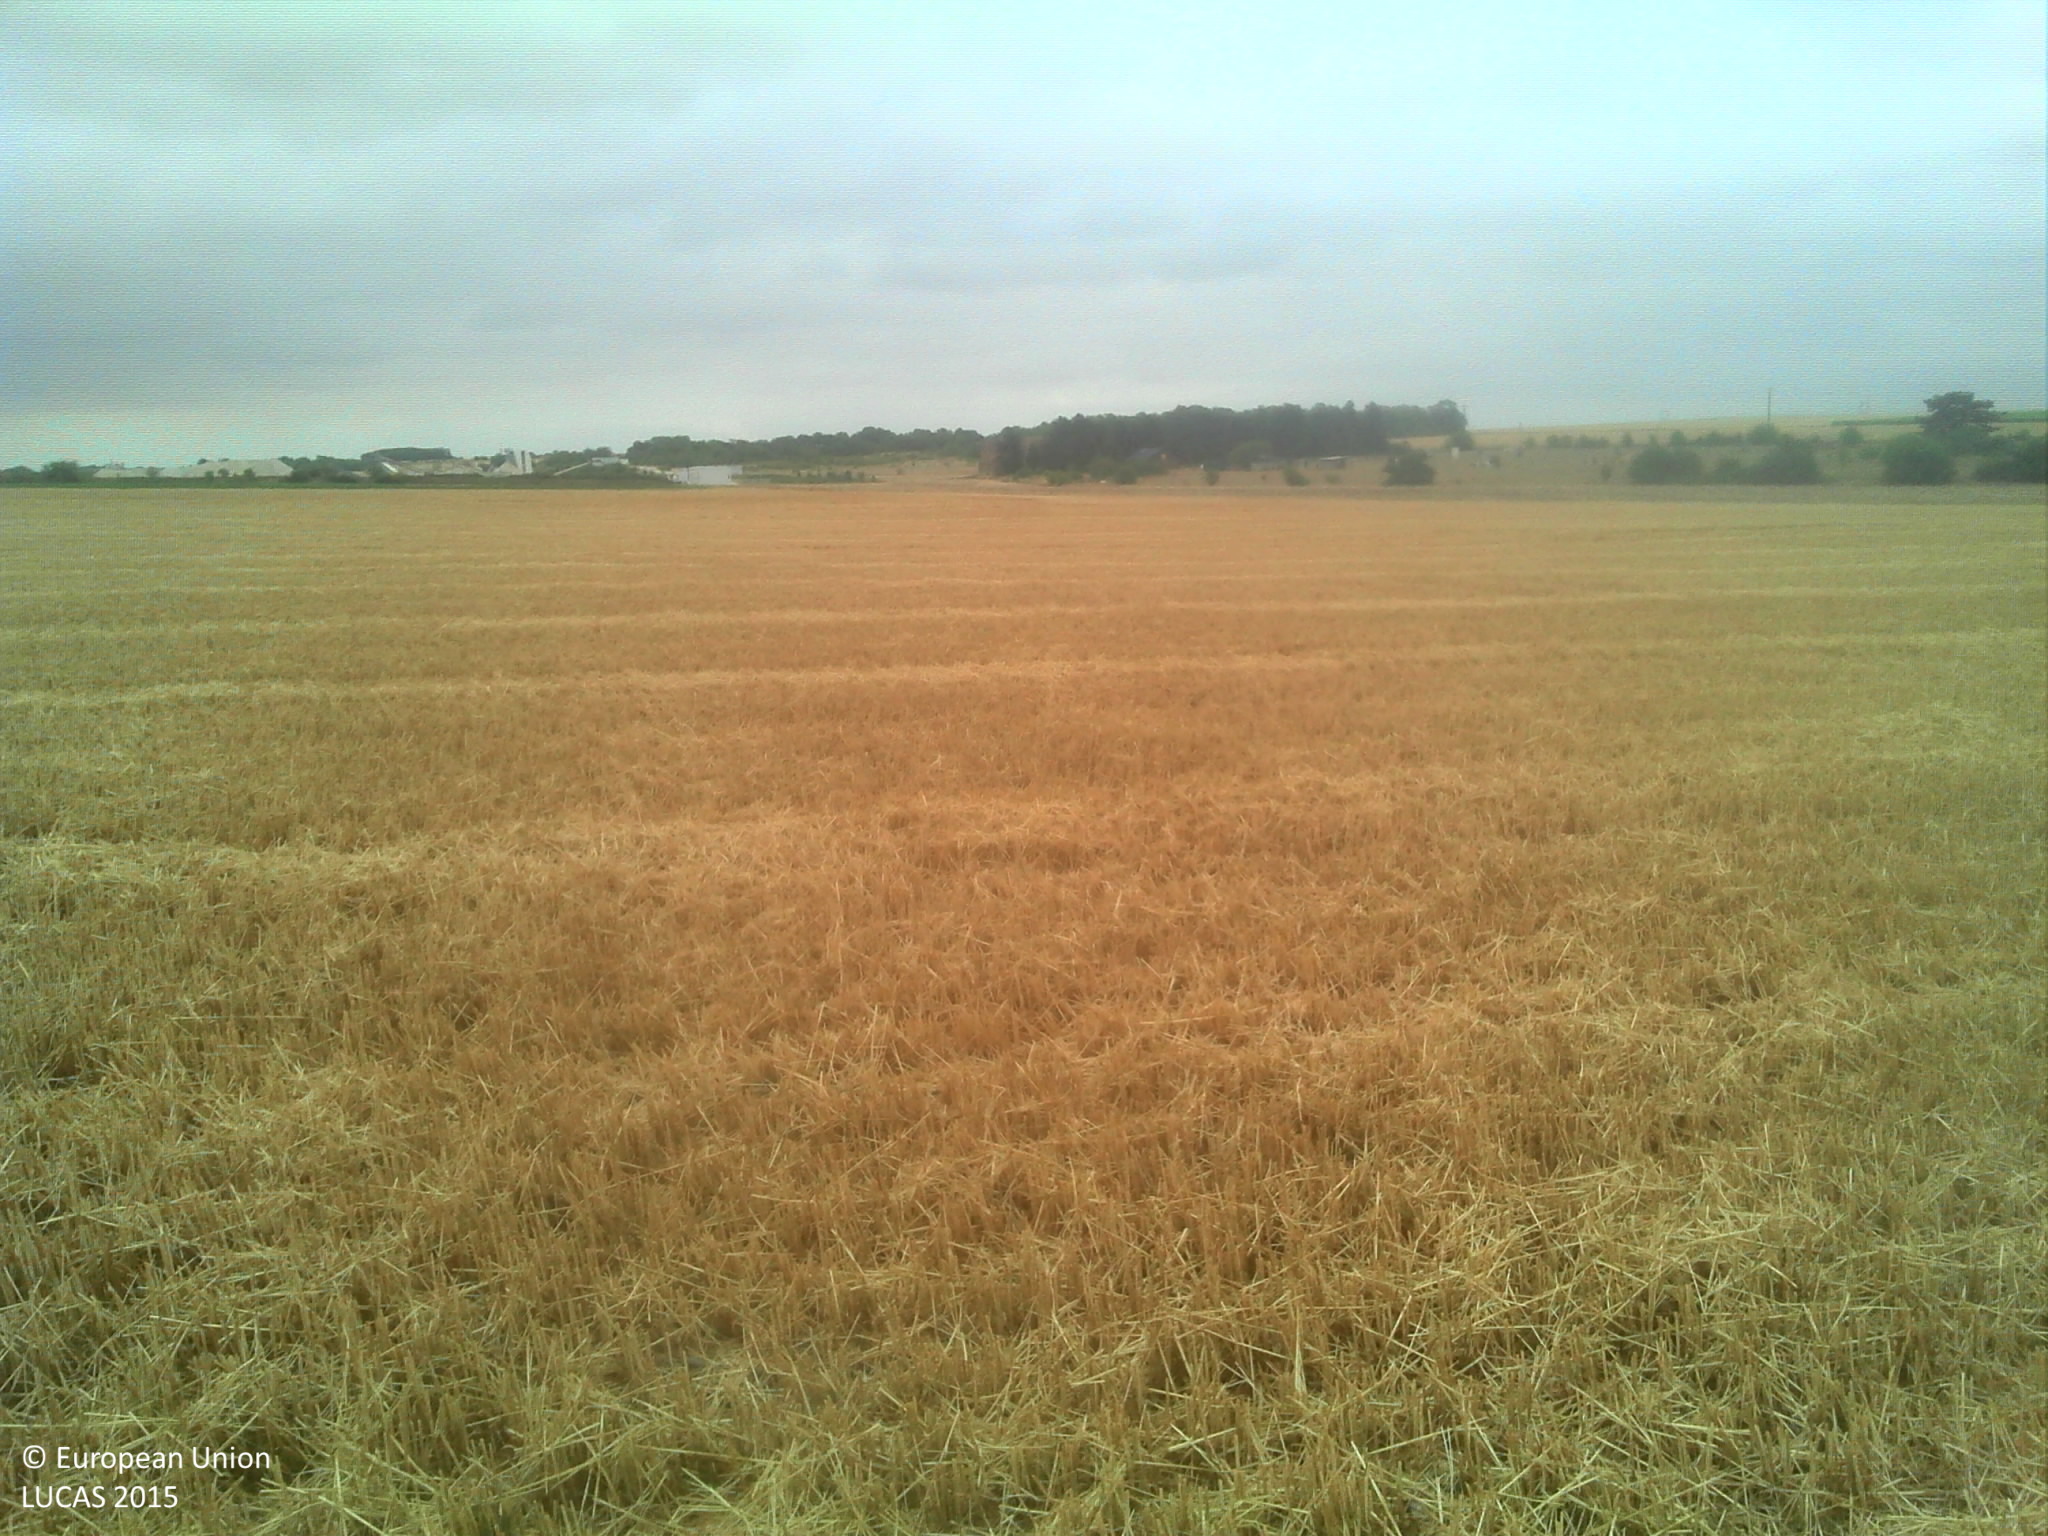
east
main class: Cropland
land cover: Durum wheat
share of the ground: > 75 %
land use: Agriculture (excluding fallow land and kitchen gardens)
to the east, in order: Durum wheat; Rape and turnip rape
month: July
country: FR
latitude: 47.6831
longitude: 1.3388
